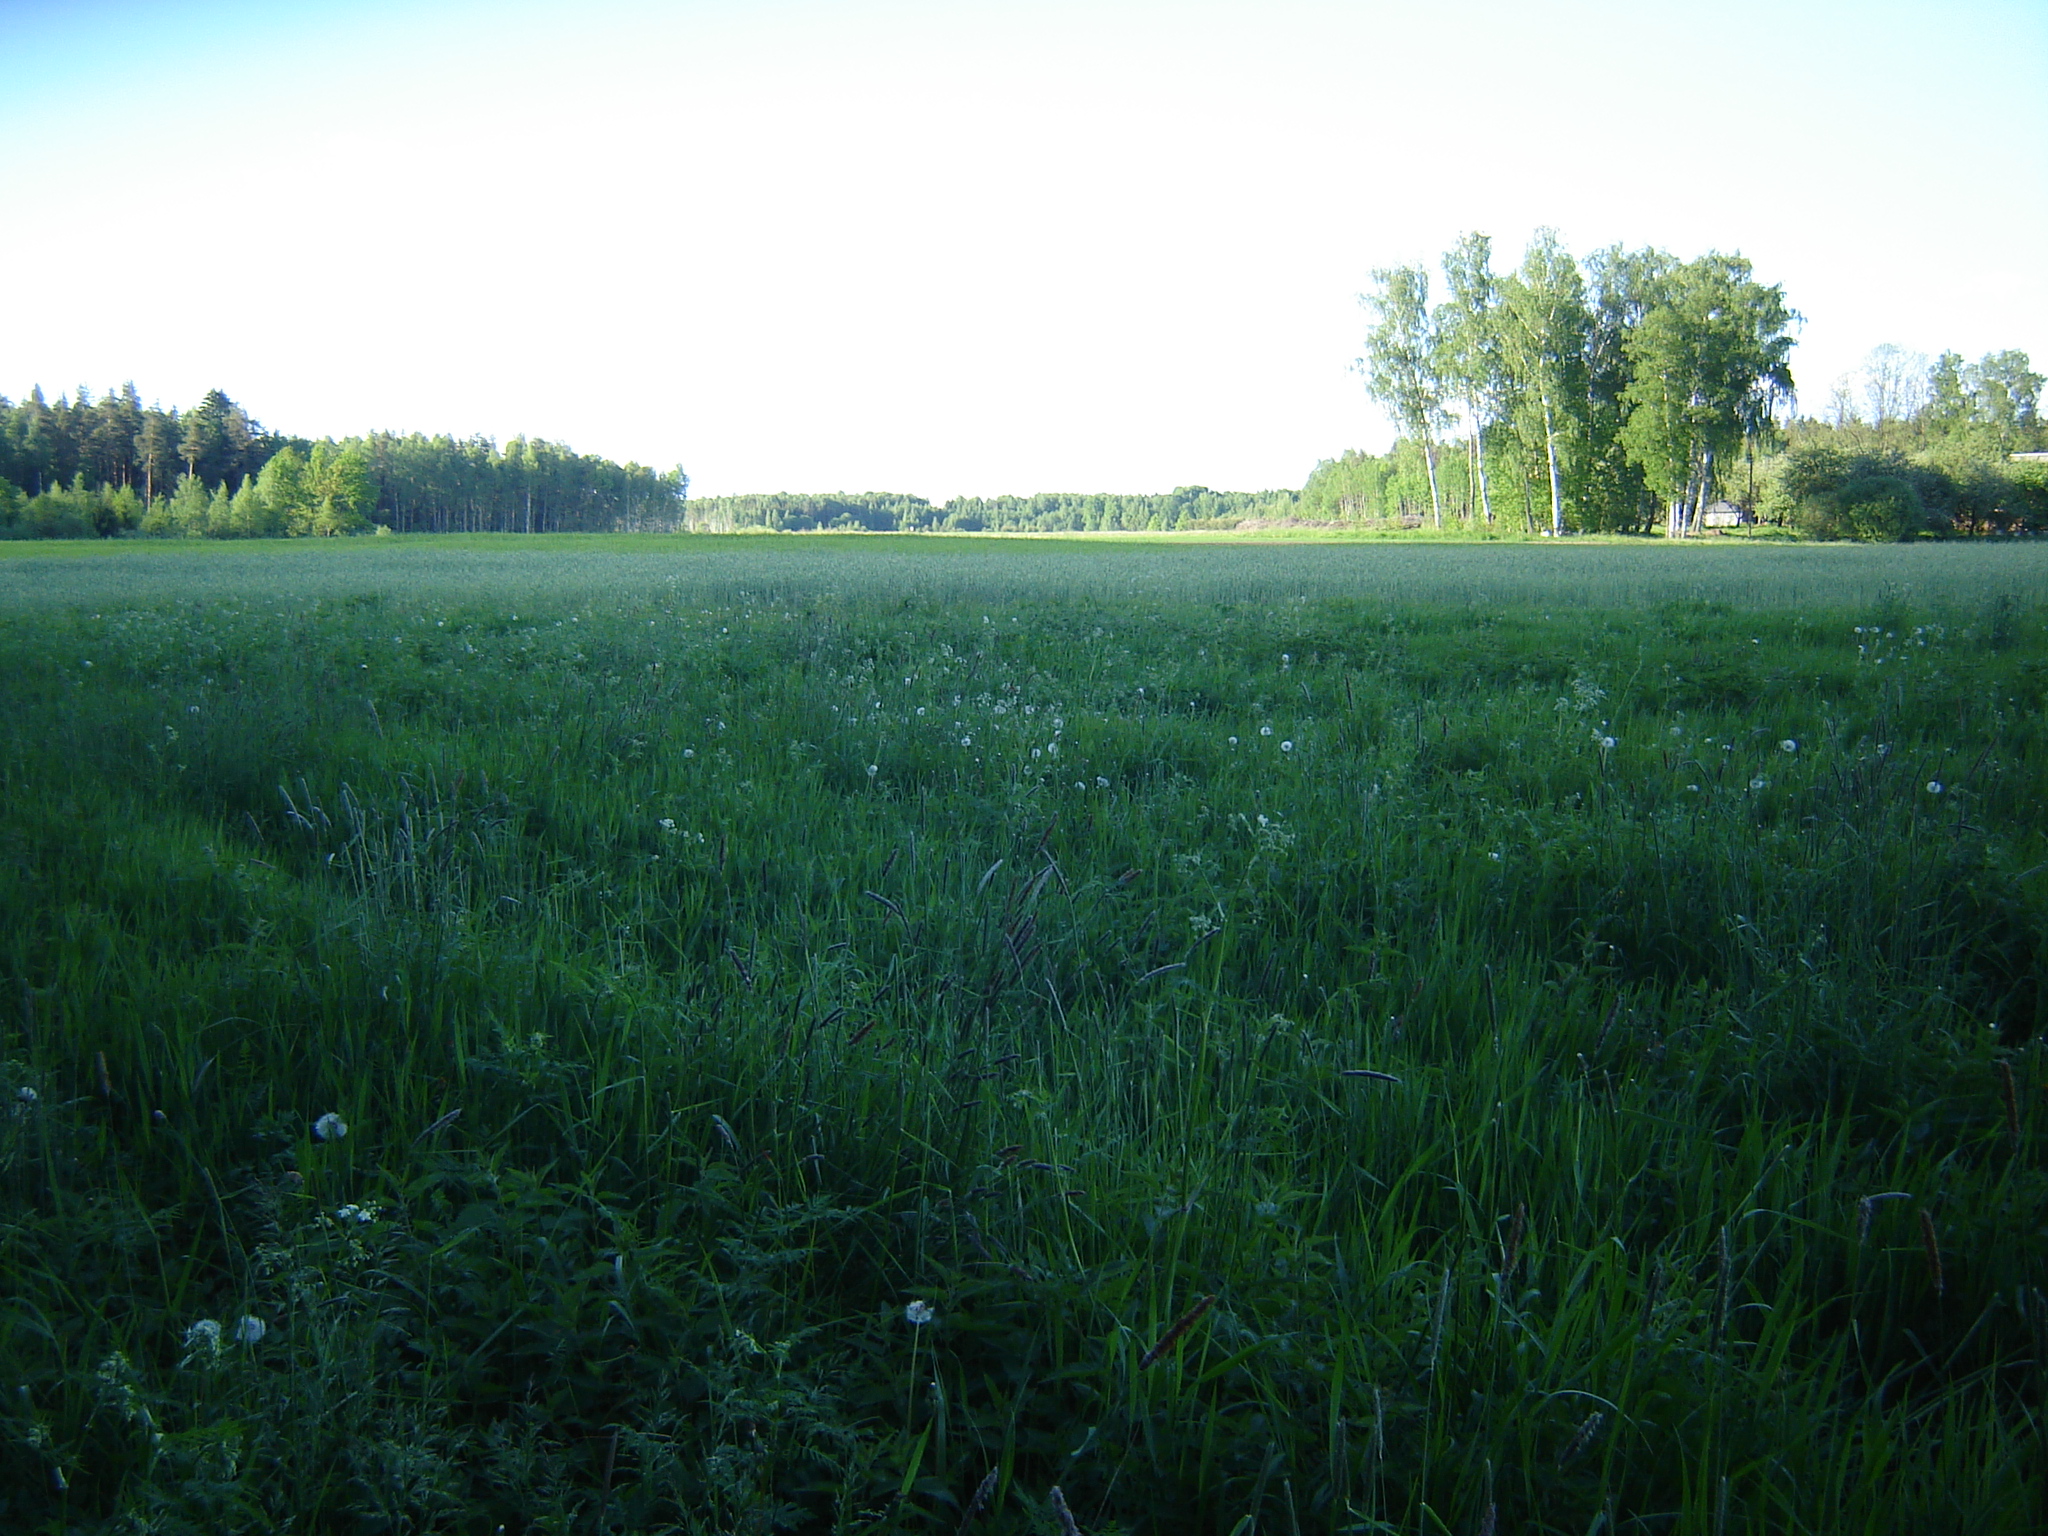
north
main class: Grassland
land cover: Spontaneously vegetated surfaces
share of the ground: > 75 %
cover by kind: herbaceous plants 100 %
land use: Fallow land
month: May
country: LT
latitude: 55.7645
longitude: 25.2418
